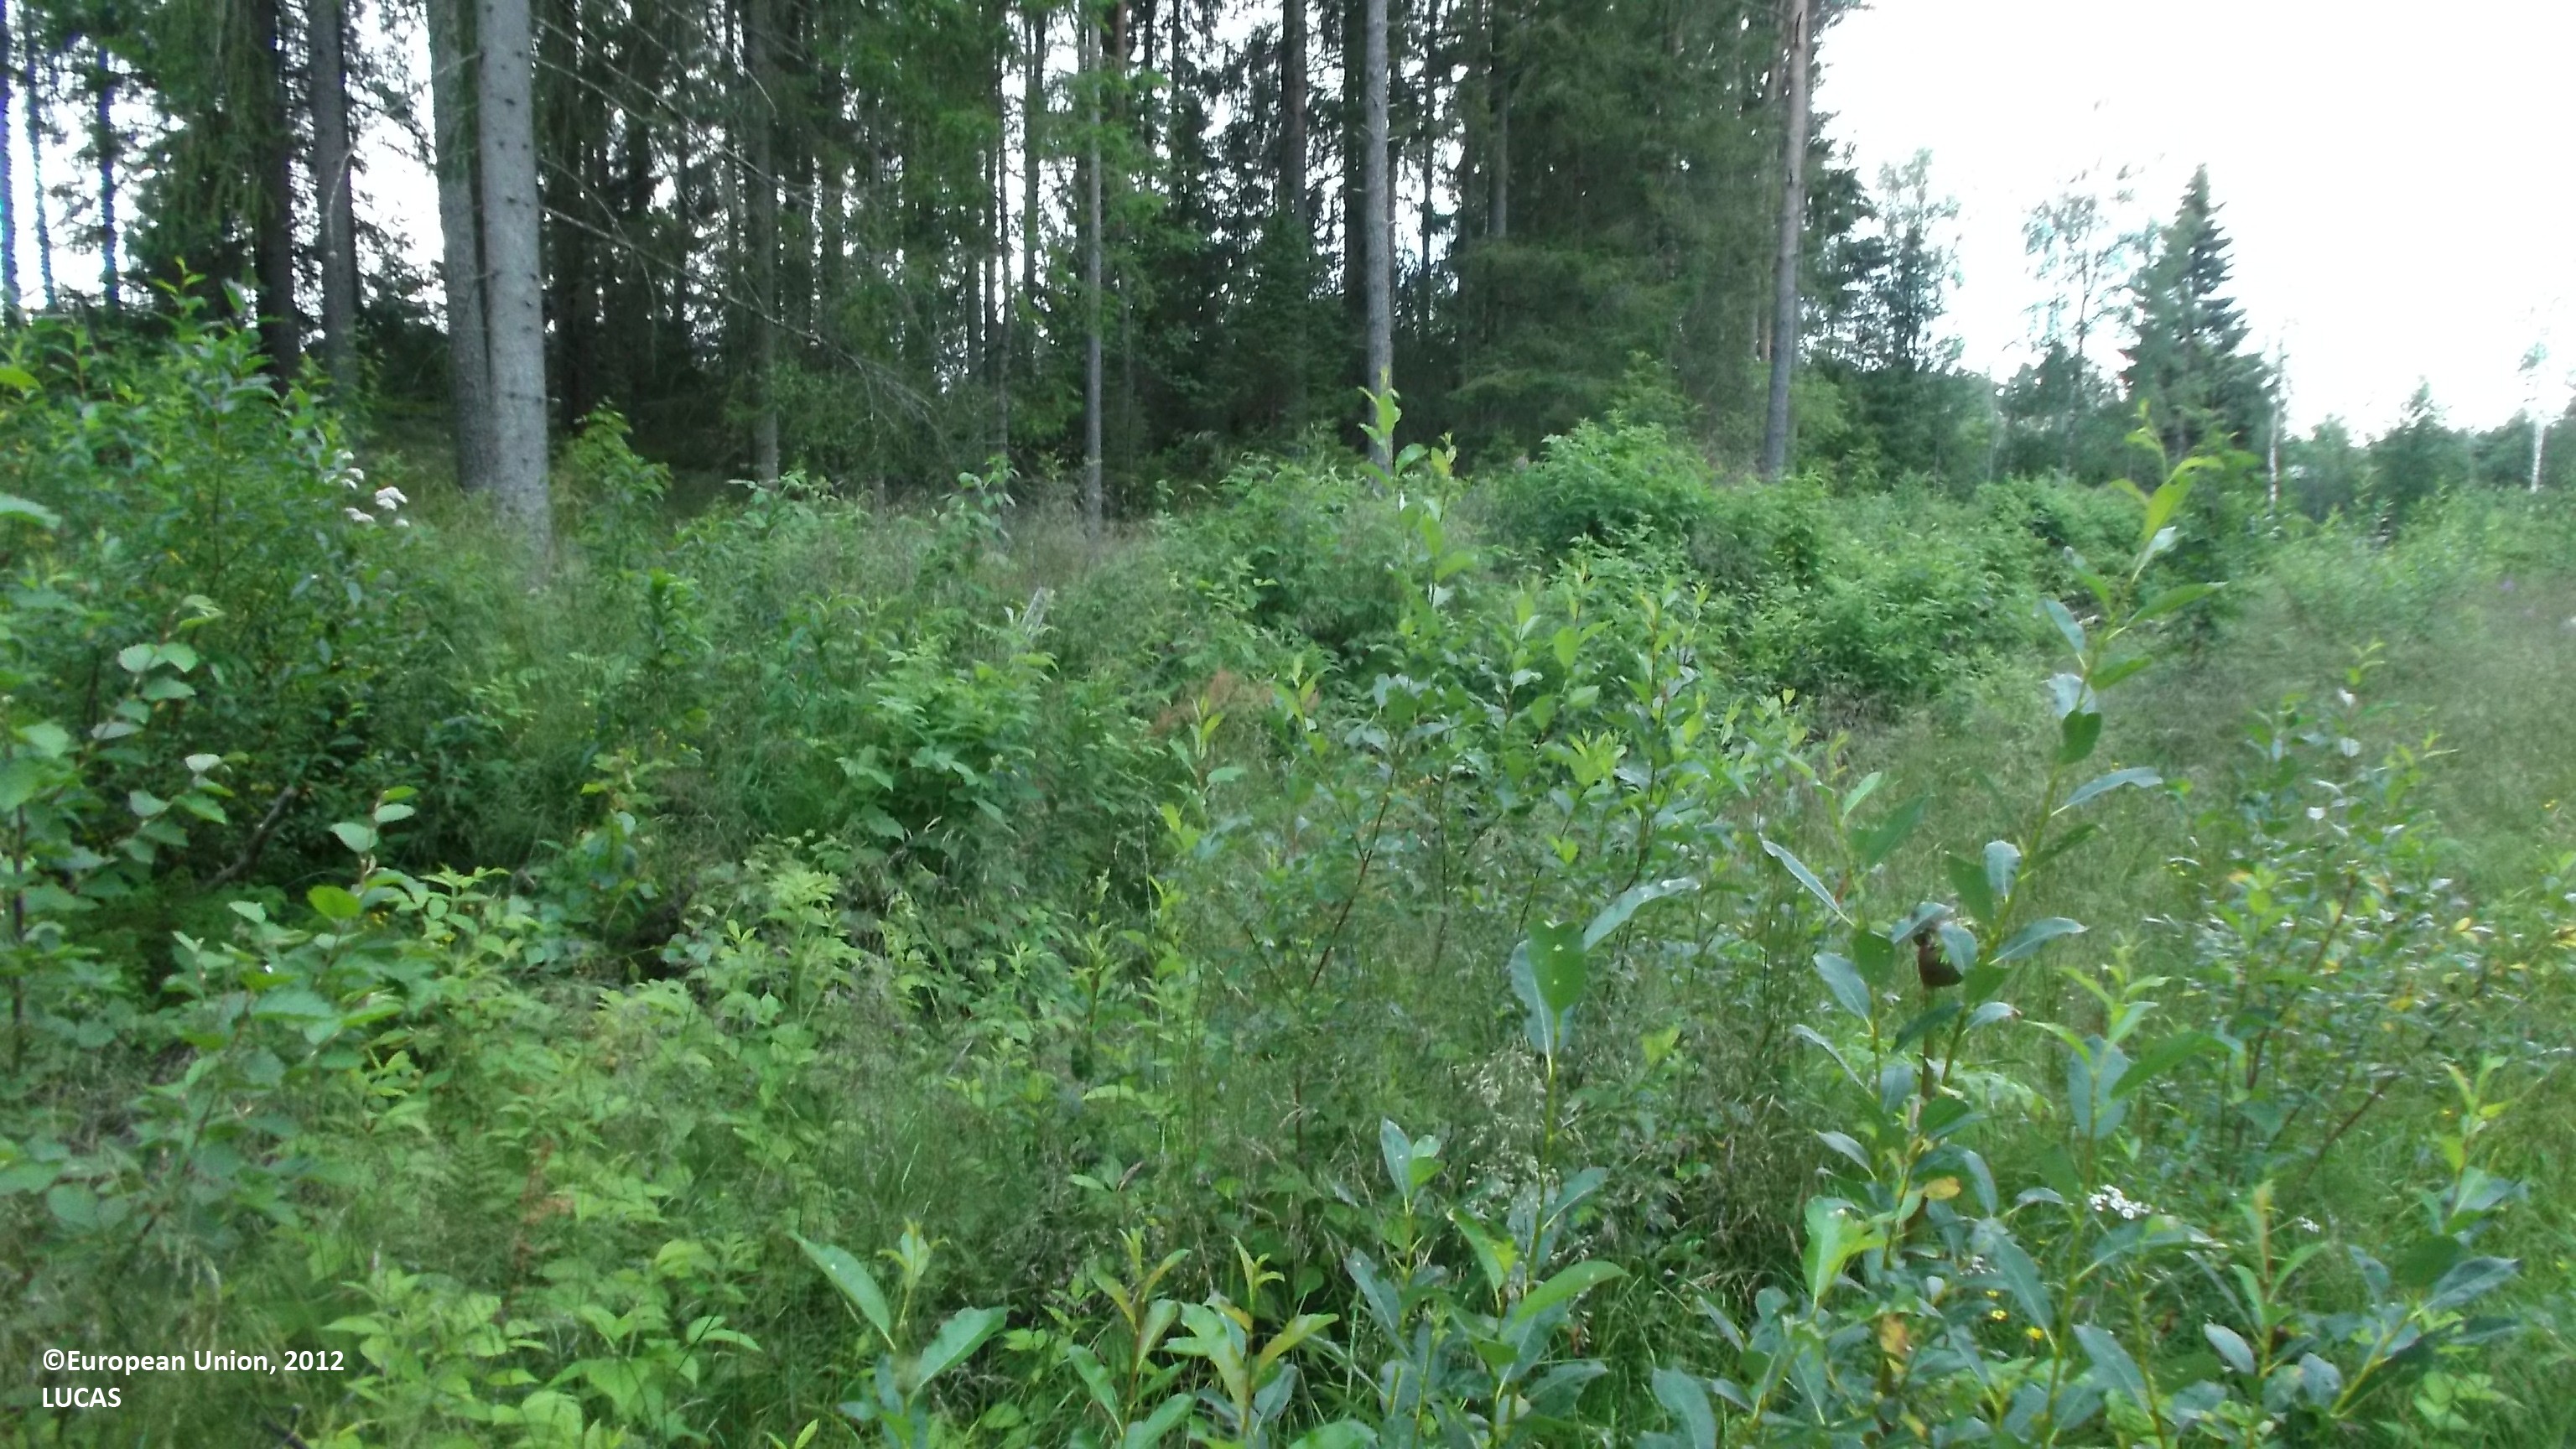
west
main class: Shrubland
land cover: Shrubland with sparse tree cover
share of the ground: > 75 %
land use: Forestry
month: July
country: FI
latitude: 63.6991
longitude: 23.3889
